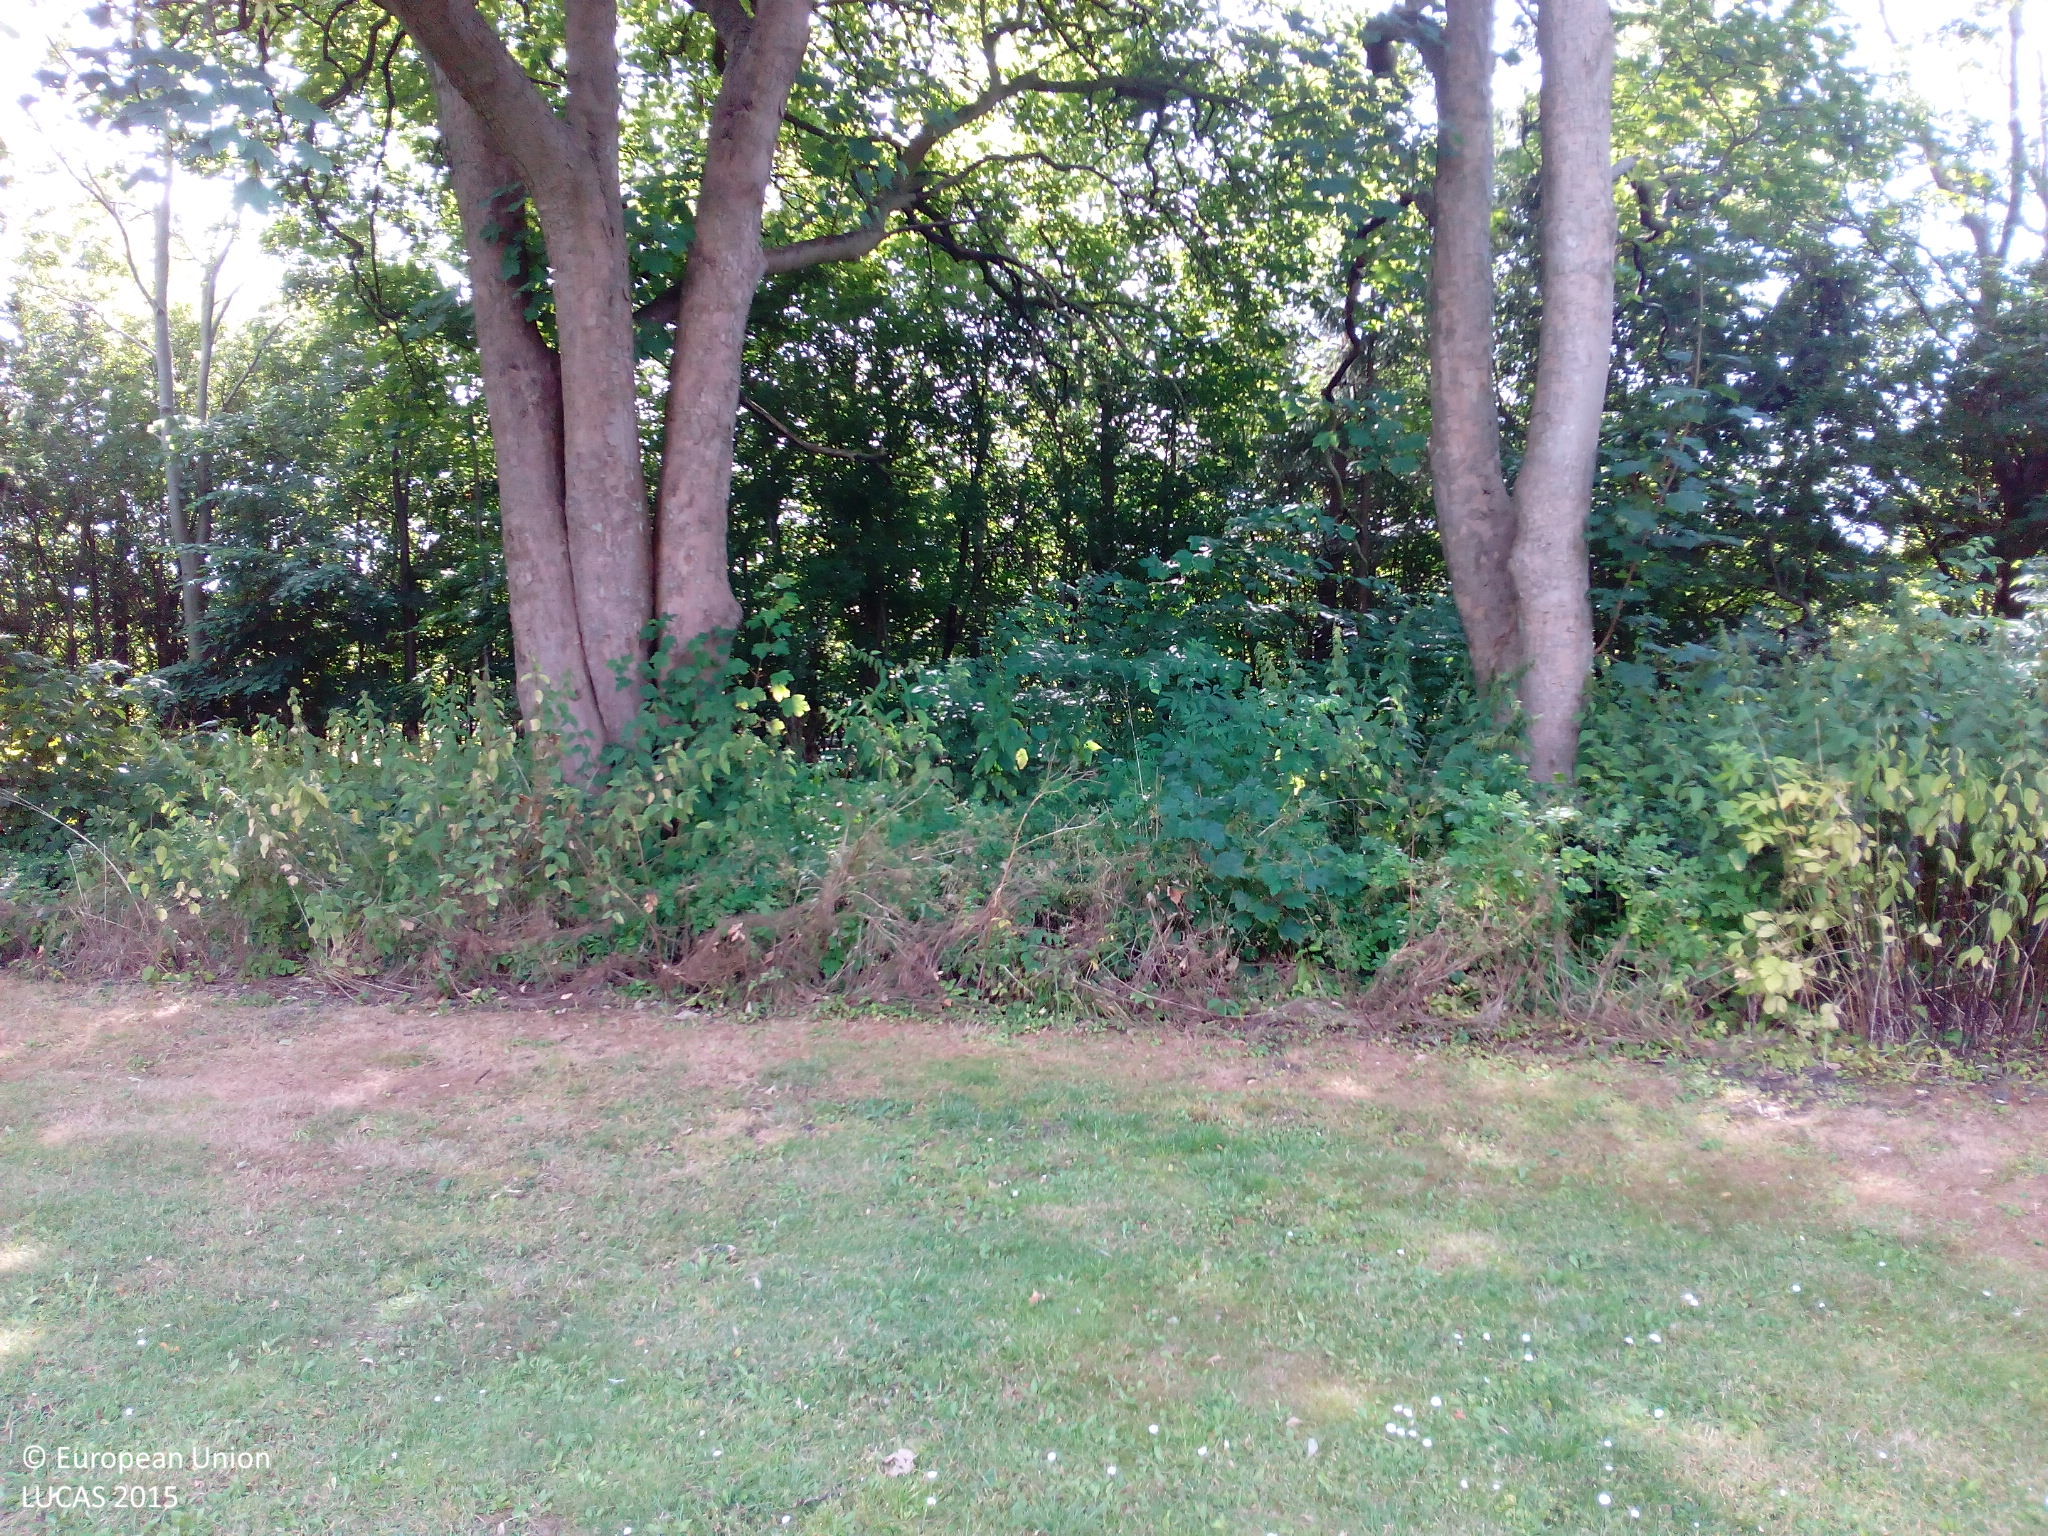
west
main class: Grassland
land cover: Grassland without tree/shrub cover
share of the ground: > 75 %
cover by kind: herbaceous plants 100 %
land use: Residential
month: August
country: DK
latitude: 55.6125
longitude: 12.1415
